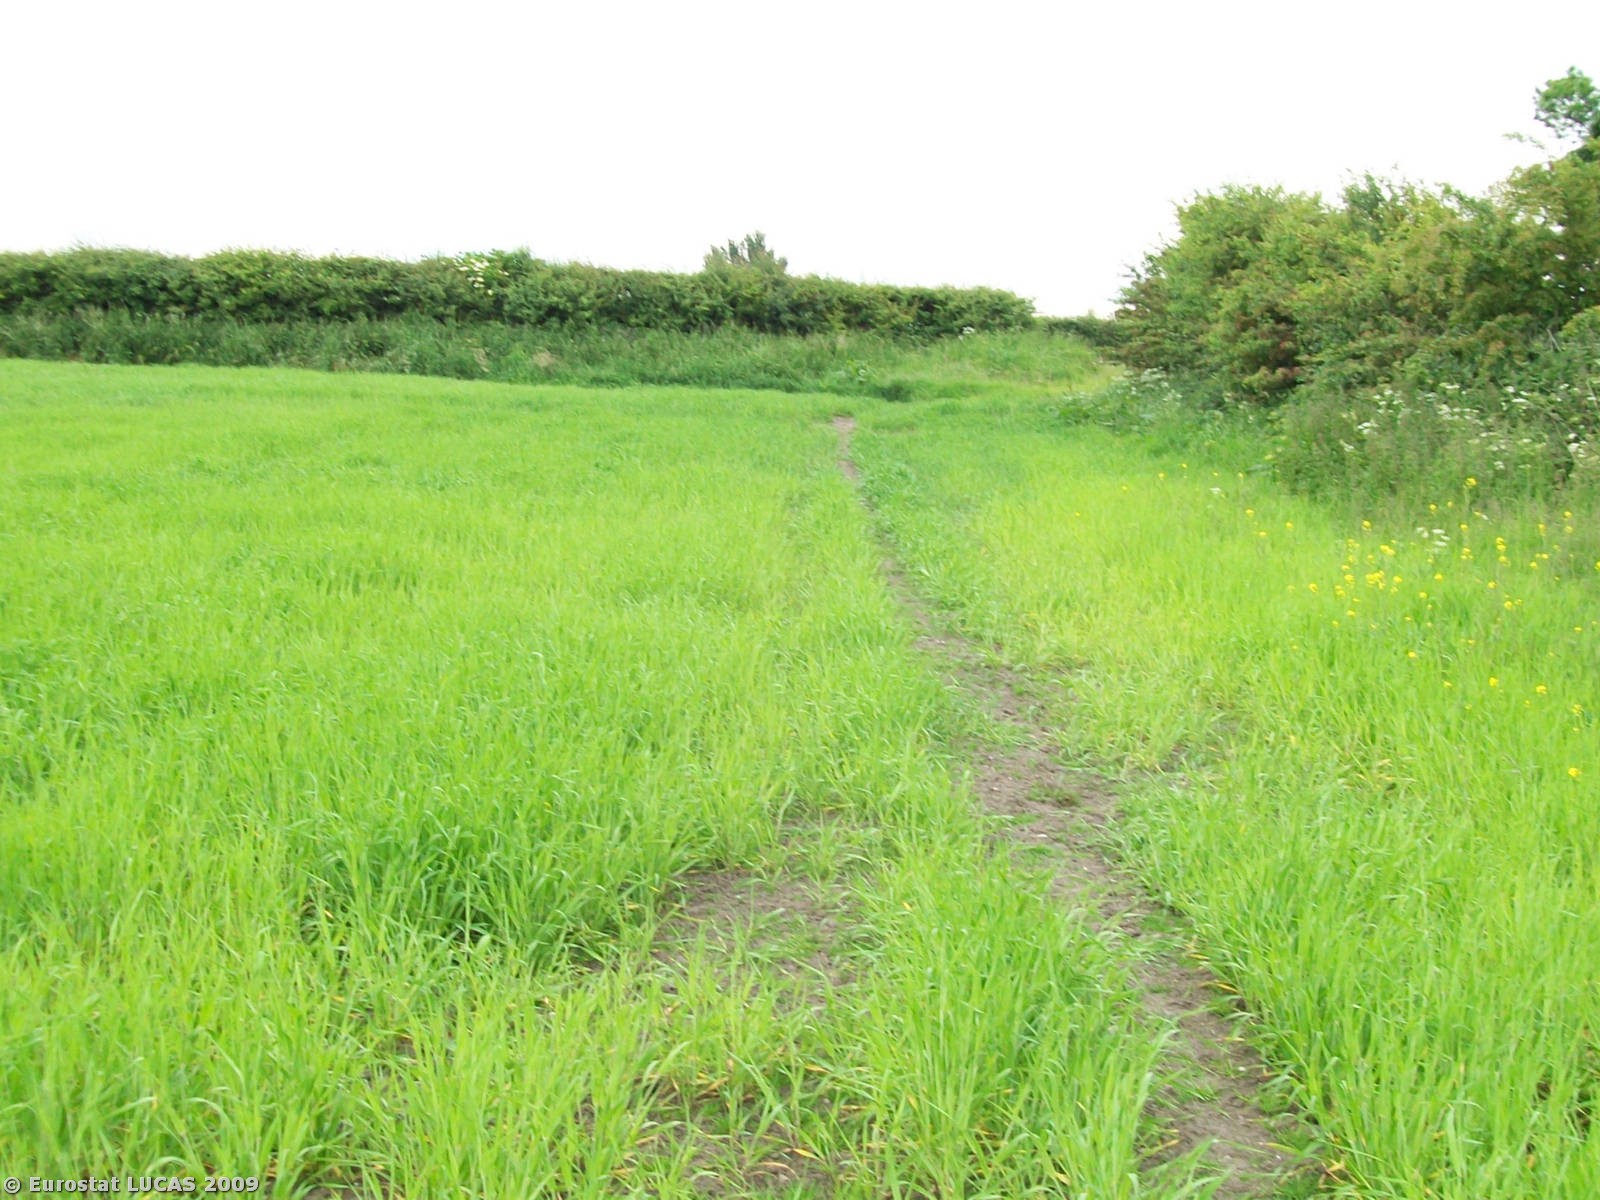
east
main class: Cropland
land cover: Barley
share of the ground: < 10 %
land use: Agriculture (excluding fallow land and kitchen gardens)
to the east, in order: Barley; Grass margins; Managed hedges; Grass margins; Paved roads, cycling and walking lanes; Other structural elements; Managed hedges; Grassland without tree/shrub cover; Managed hedges; Grassland without tree/shrub cover
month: June
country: GB
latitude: 53.4483
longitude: -2.7938
